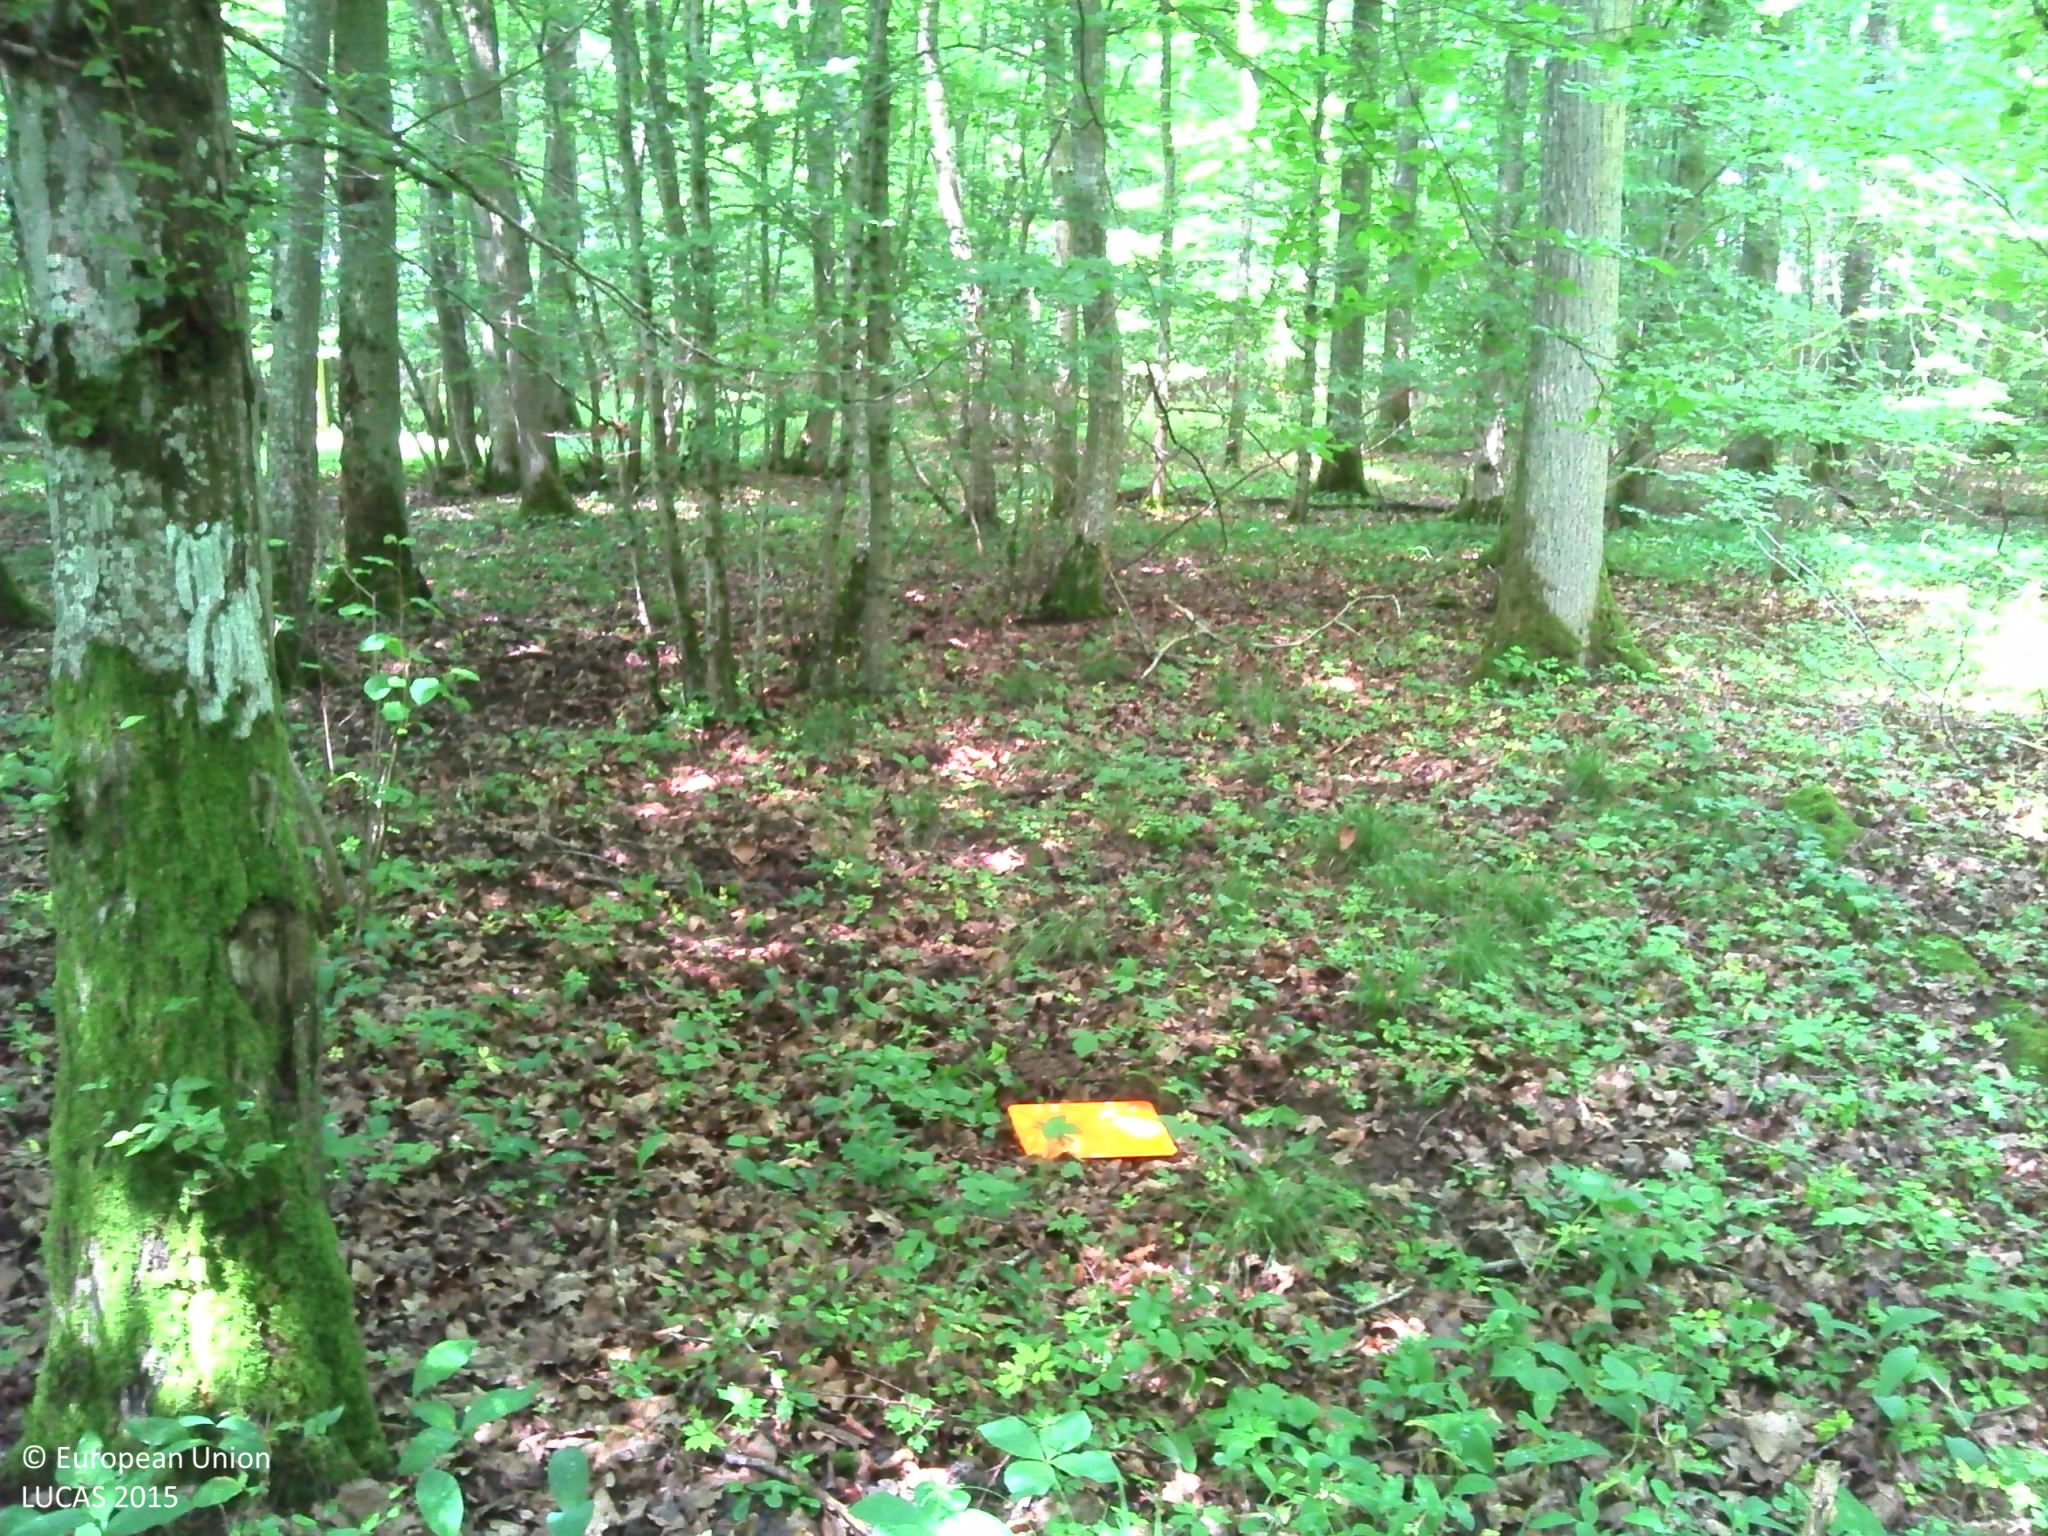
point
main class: Woodland
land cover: Broadleaved woodland
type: mesophytic deciduous forest
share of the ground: > 75 %
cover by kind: broadleaved forest trees 90 %, lichens and mosses 10 %
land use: Forestry
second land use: Amenities, museums, leisure
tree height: > 5 m
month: June
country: FR
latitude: 48.7251
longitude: 5.9351
